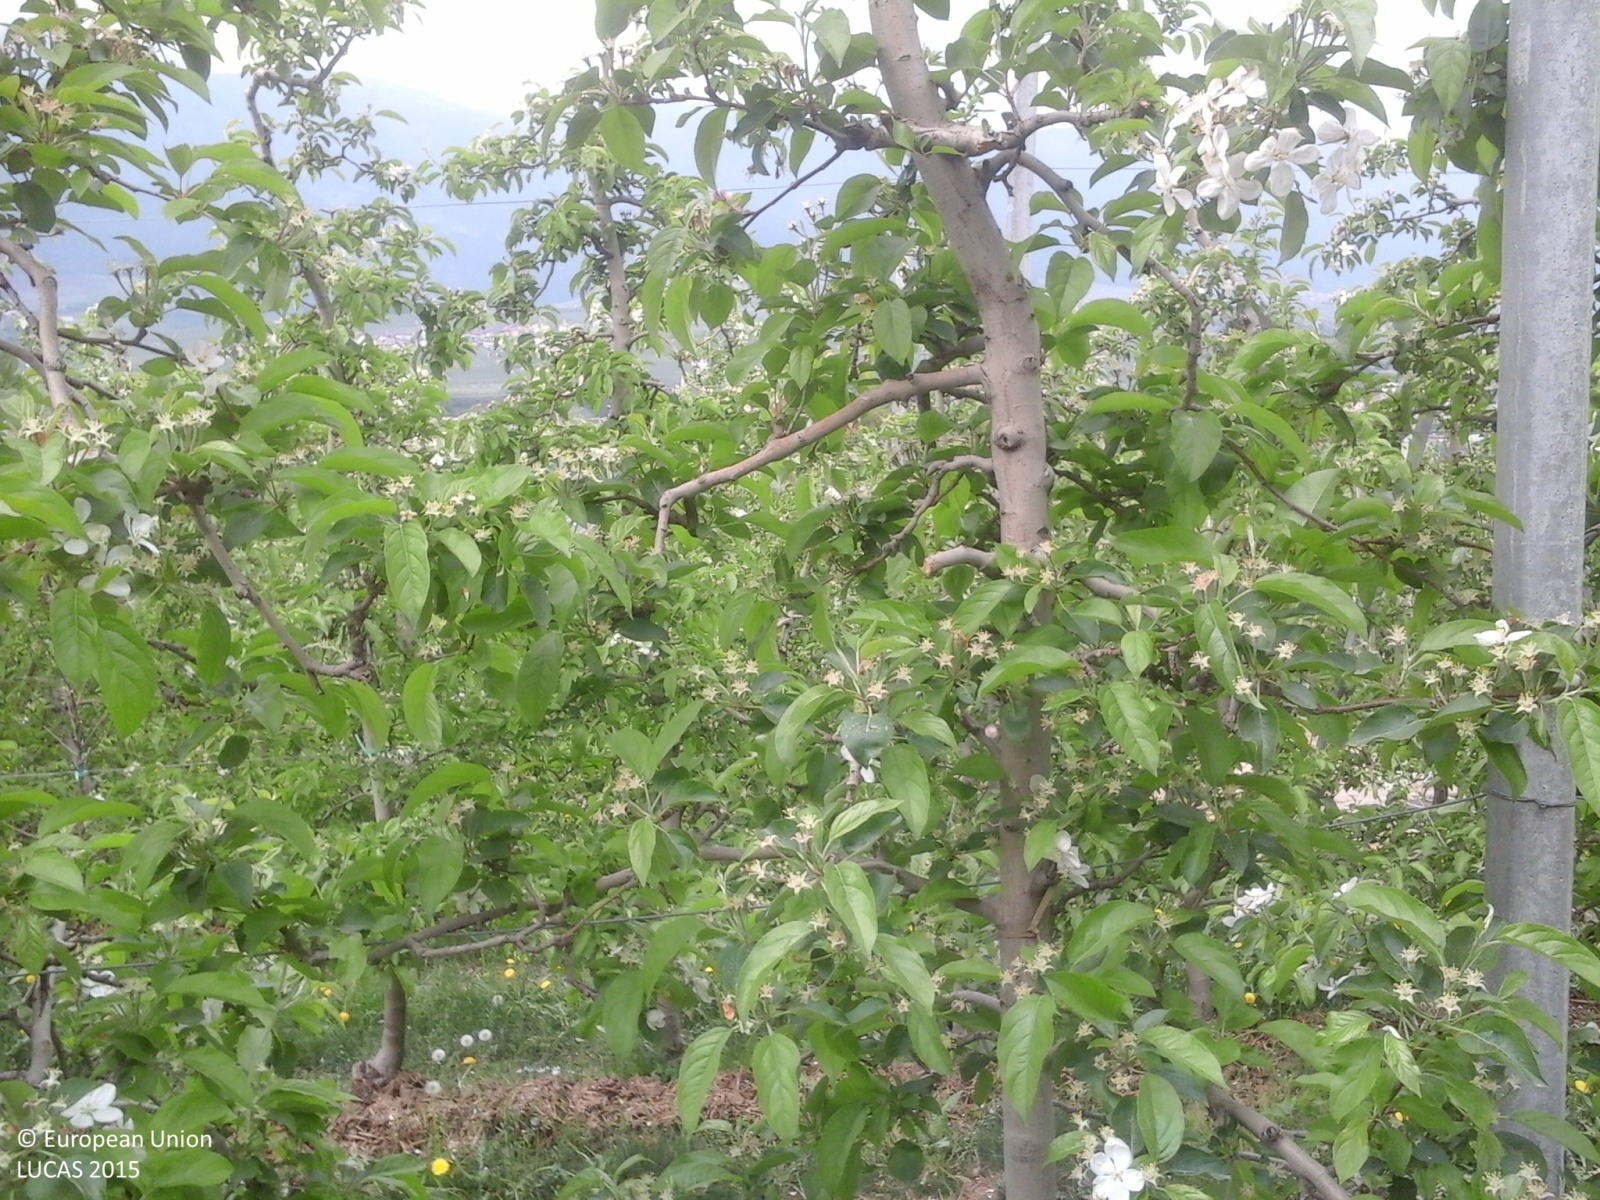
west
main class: Cropland
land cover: Apple fruit
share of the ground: 25 - 50 %
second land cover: Grassland without tree/shrub cover
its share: > 75 %
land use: Agriculture (excluding fallow land and kitchen gardens)
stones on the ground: < 10 %
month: April
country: IT
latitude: 46.3098
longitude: 11.0763
